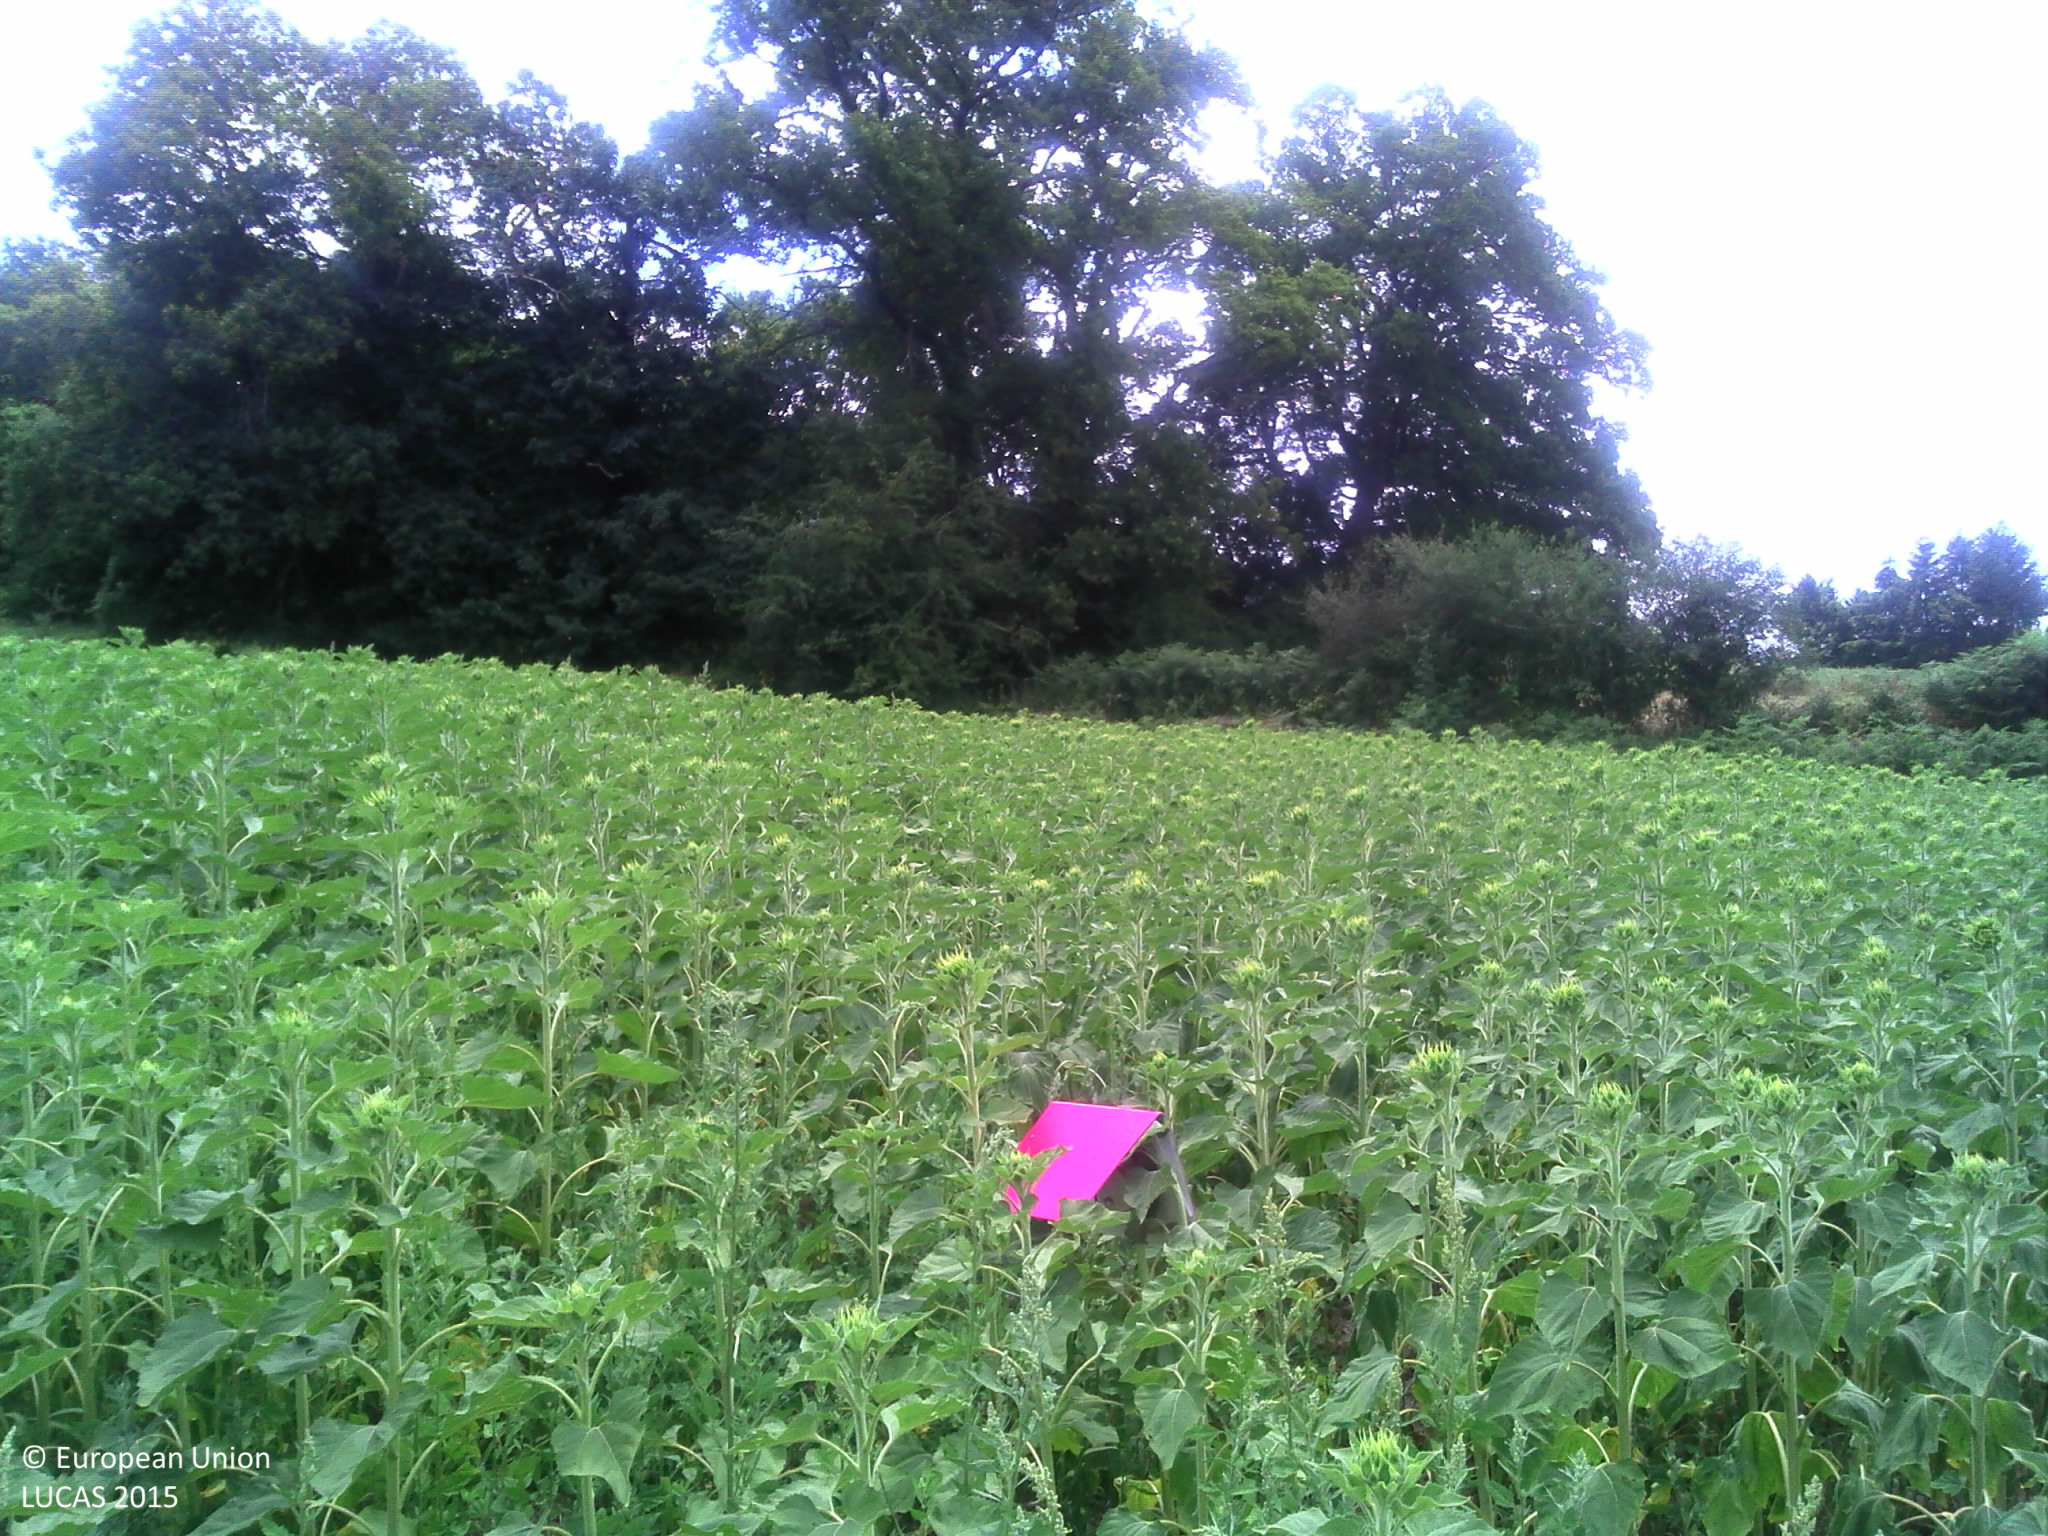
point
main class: Cropland
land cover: Sunflower
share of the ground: > 75 %
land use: Agriculture (excluding fallow land and kitchen gardens)
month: July
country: FR
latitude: 46.3649
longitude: 1.6071
